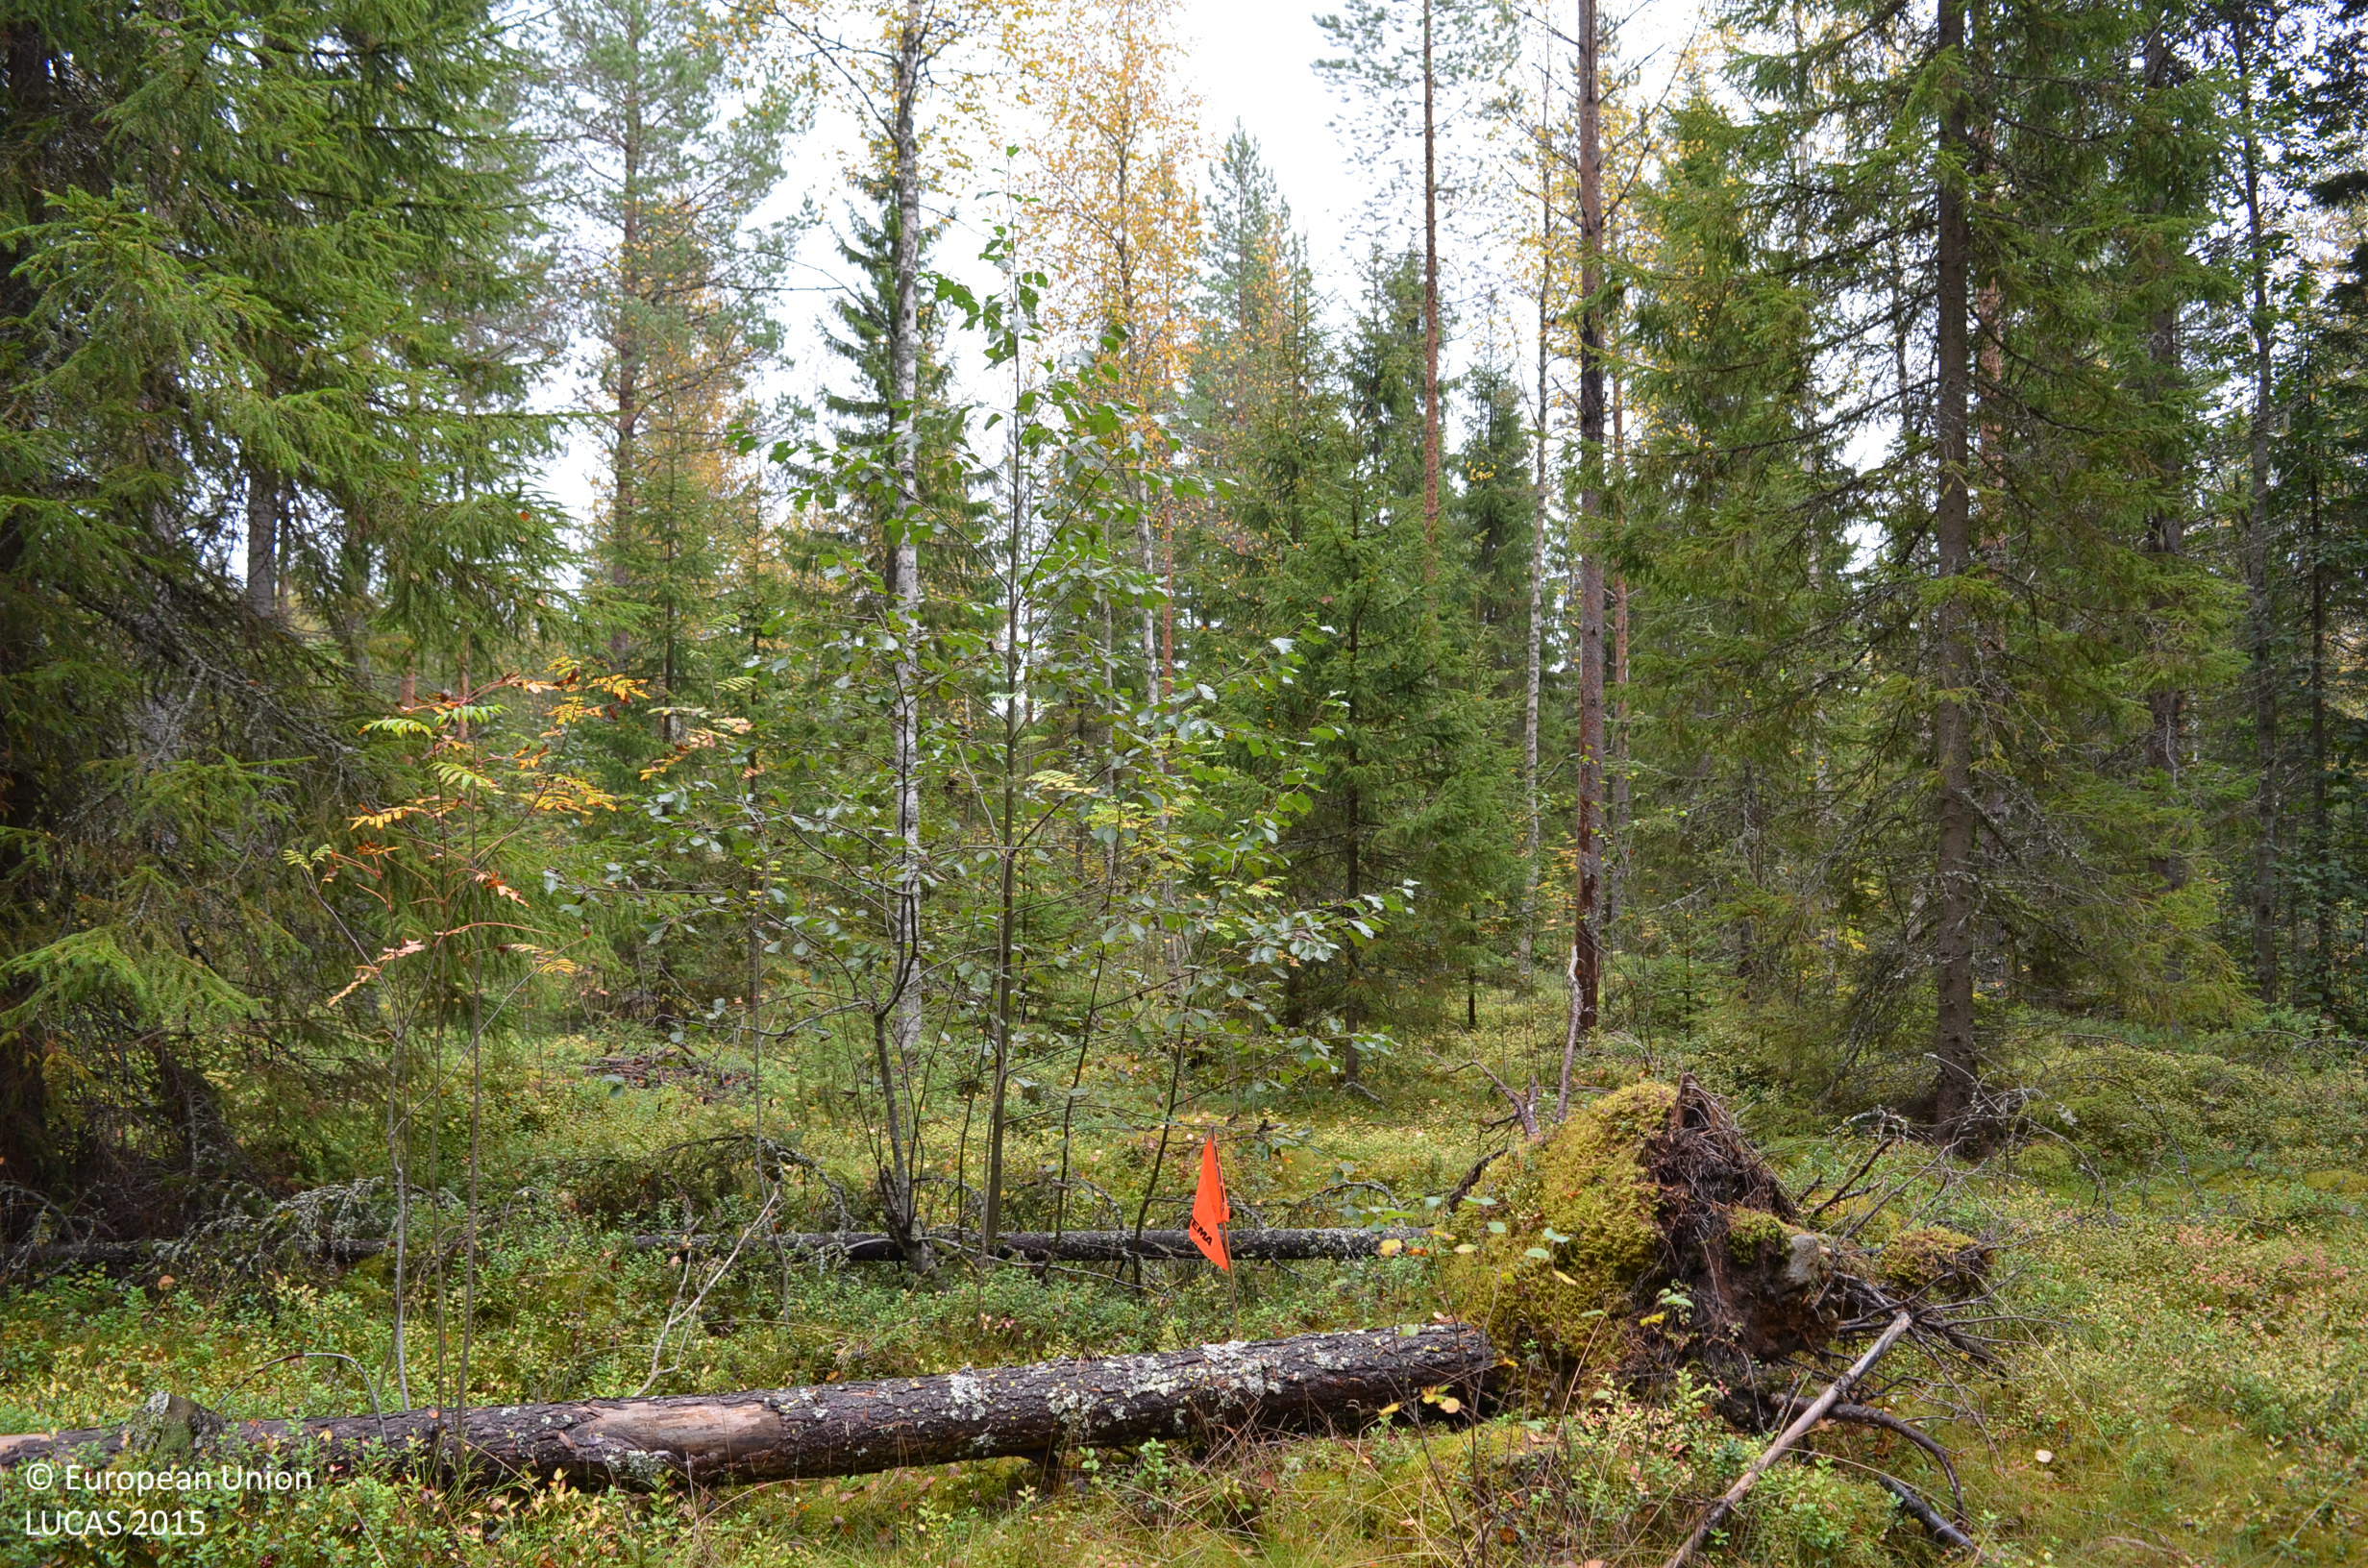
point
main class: Woodland
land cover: Other mixed woodland
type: boreal forest
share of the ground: 50 - 75 %
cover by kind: coniferous forest trees 50 %, broadleaved forest trees 20 %, shrubs 20 %, lichens and mosses 10 %
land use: Forestry
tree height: > 5 m
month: September
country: FI
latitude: 62.5683
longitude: 23.7136
